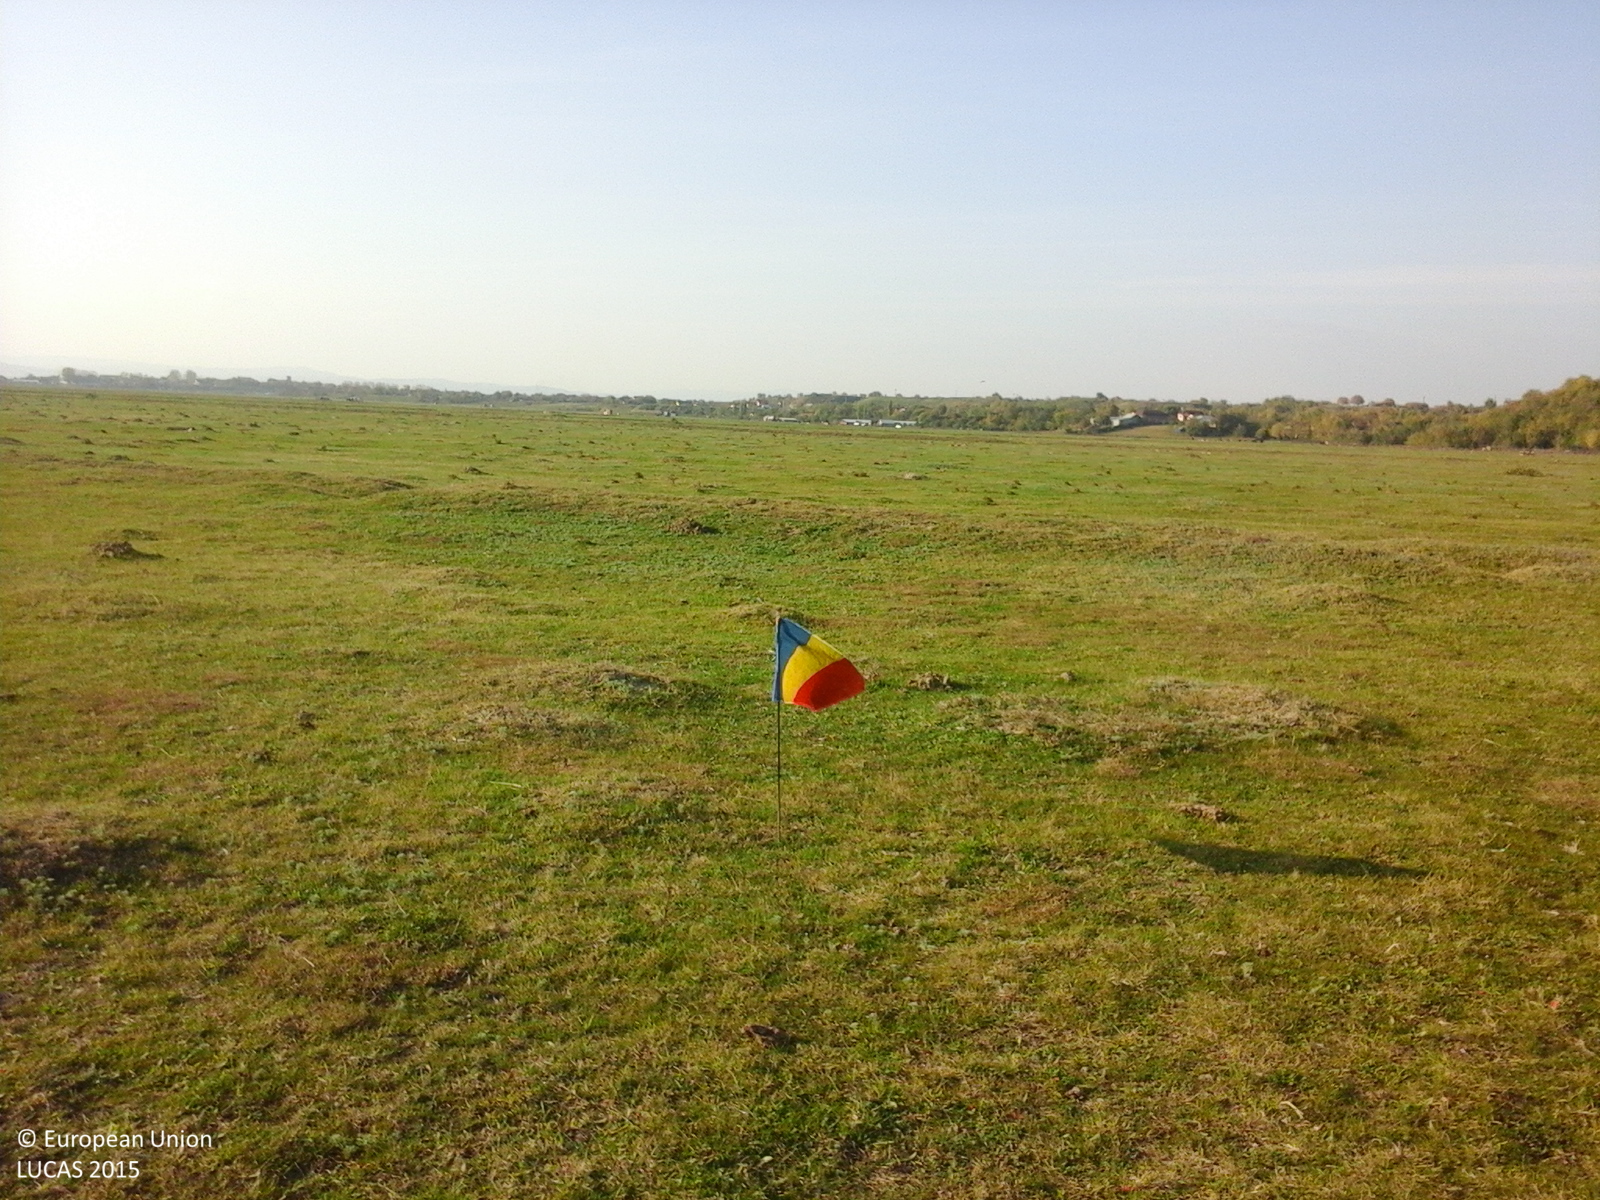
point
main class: Grassland
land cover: Grassland without tree/shrub cover
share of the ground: > 75 %
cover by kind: herbaceous plants 100 %
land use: Agriculture (excluding fallow land and kitchen gardens)
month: October
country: RO
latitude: 45.1656
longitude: 26.8622
